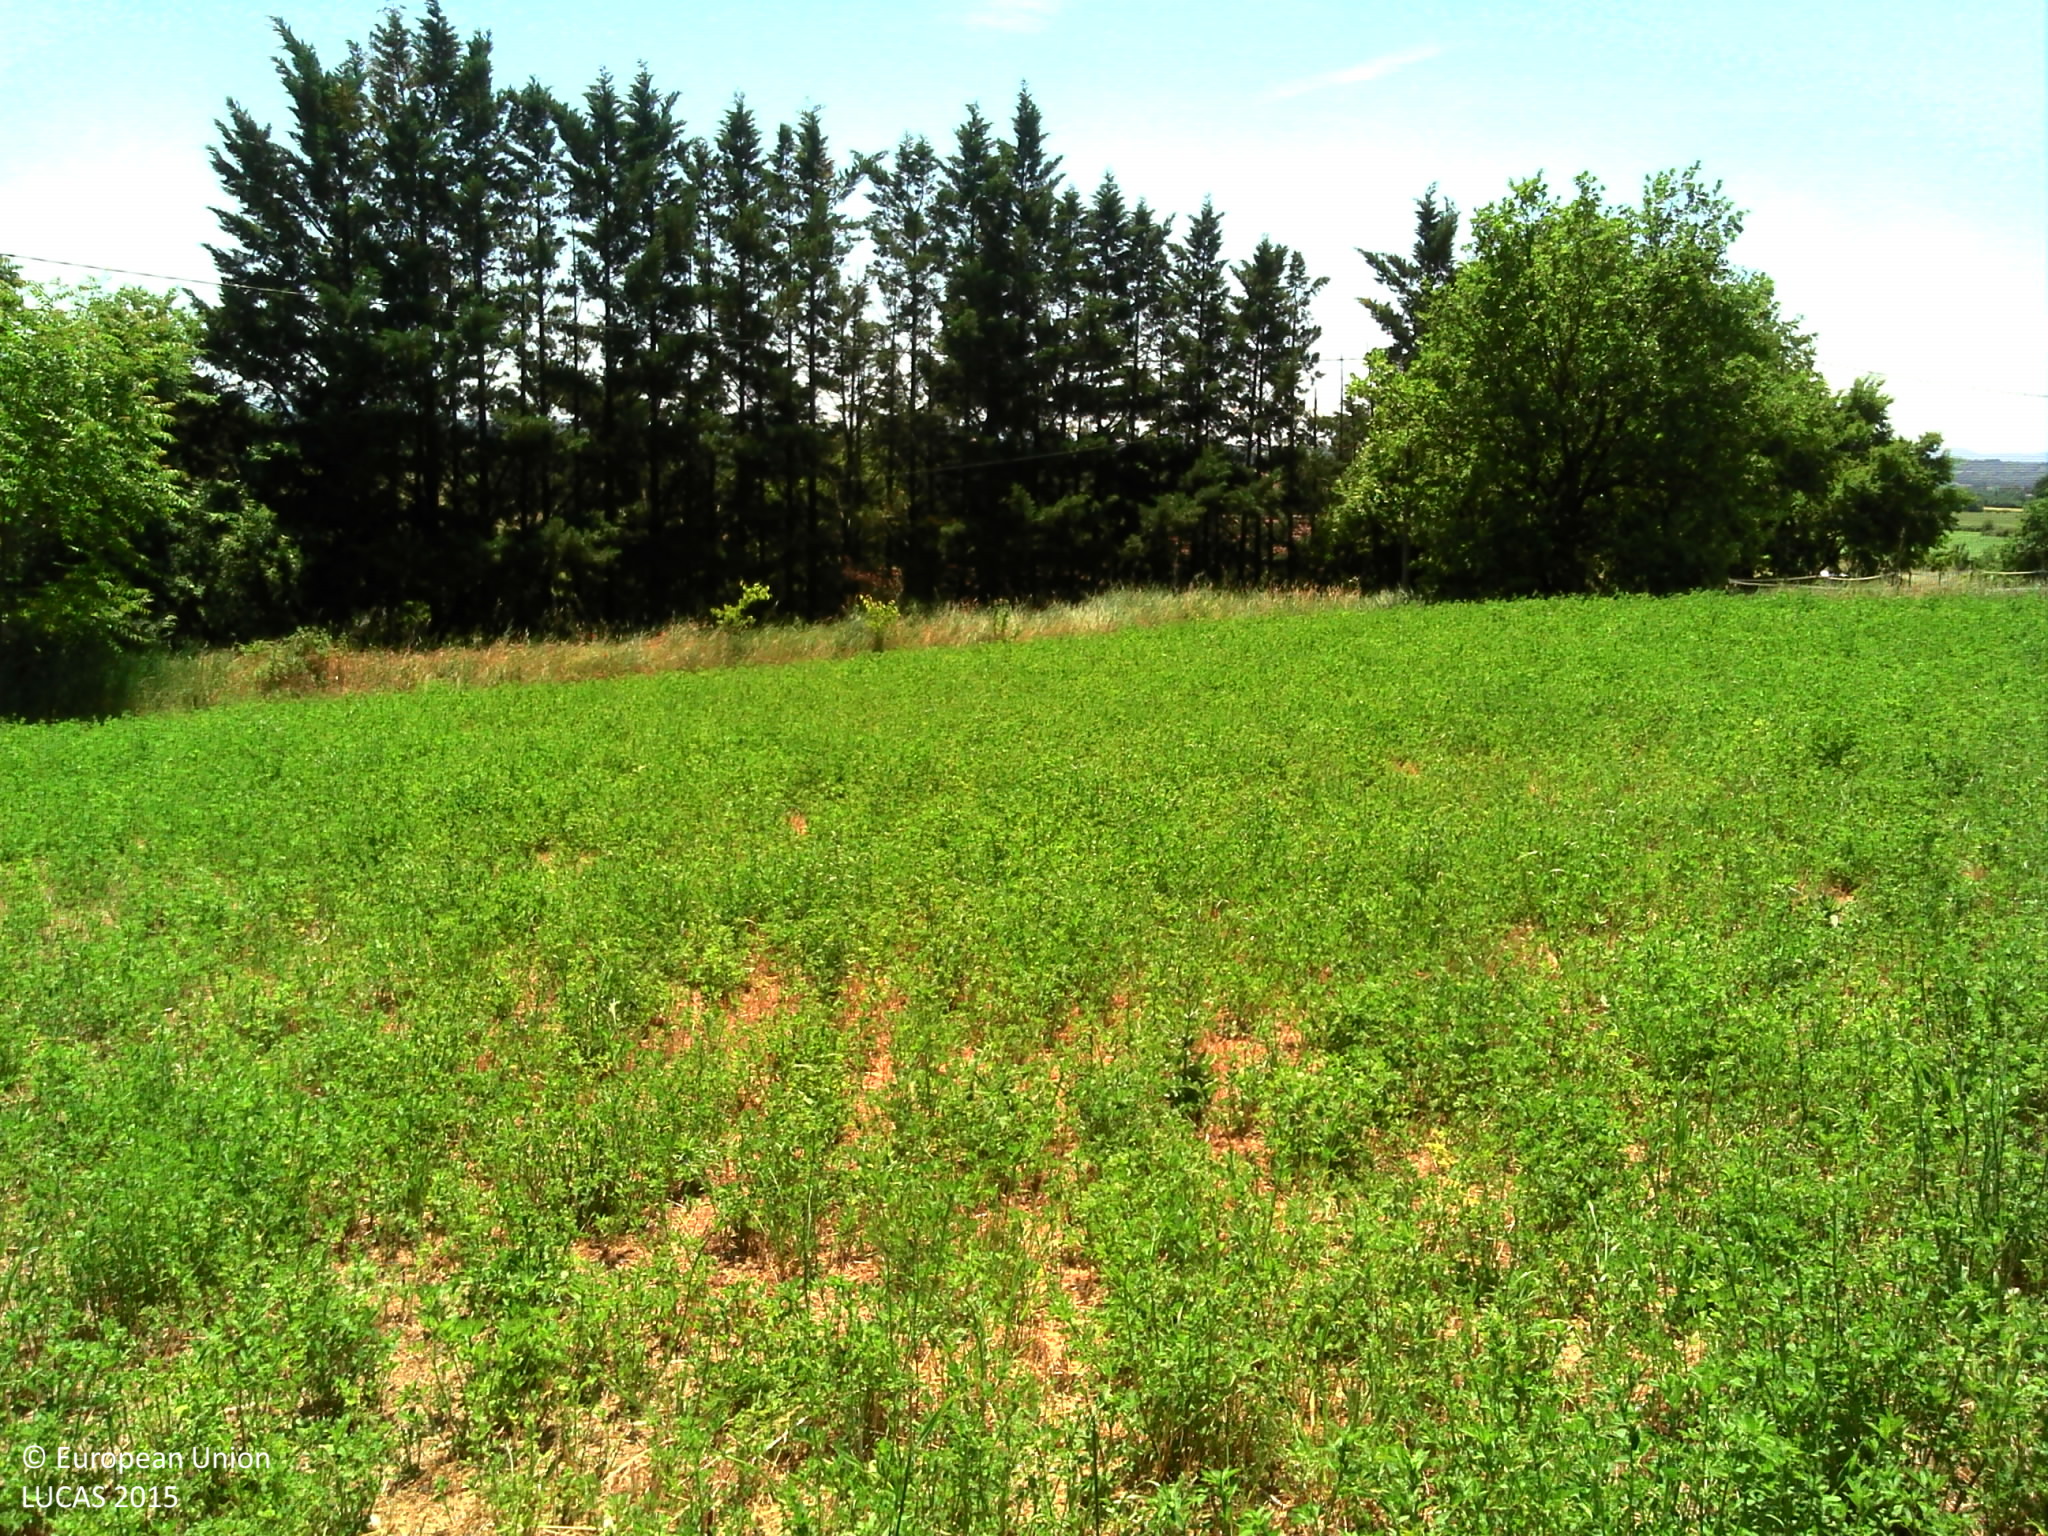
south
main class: Cropland
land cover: Lucerne
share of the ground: > 75 %
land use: Agriculture (excluding fallow land and kitchen gardens)
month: May
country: FR
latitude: 45.0617
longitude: 5.0146
